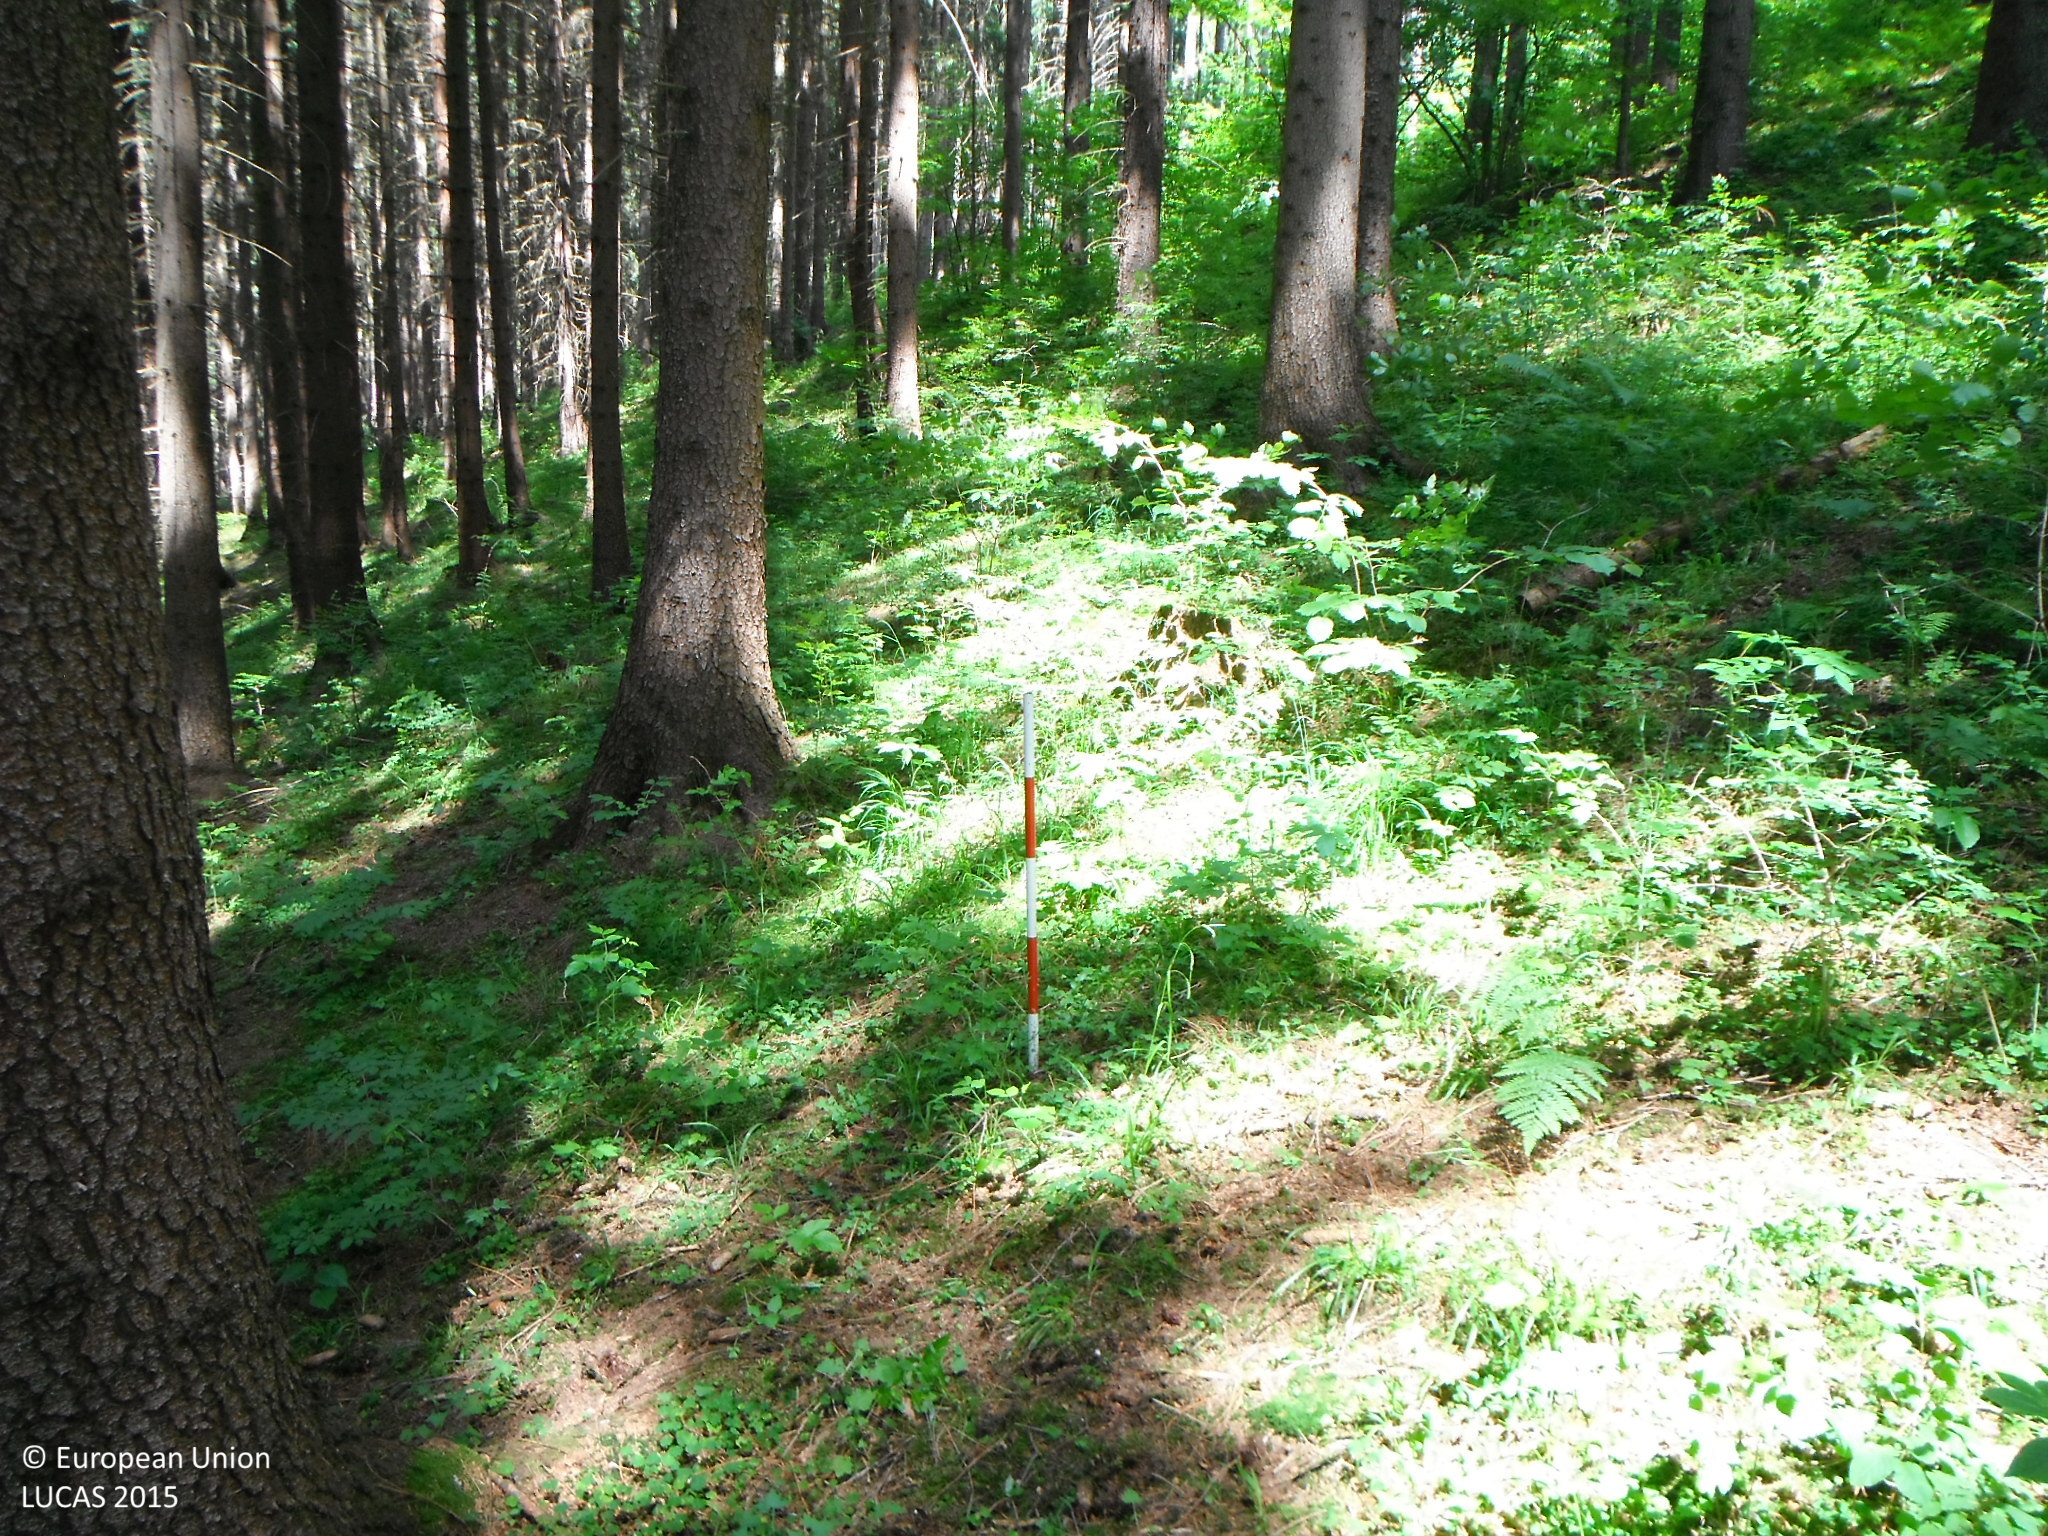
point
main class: Woodland
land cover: Spruce dominated coniferous woodland
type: alpine coniferous forest
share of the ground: > 75 %
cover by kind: coniferous forest trees 90 %, herbaceous plants 10 %
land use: Forestry
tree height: > 5 m
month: June
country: SK
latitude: 49.1890
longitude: 19.2860
